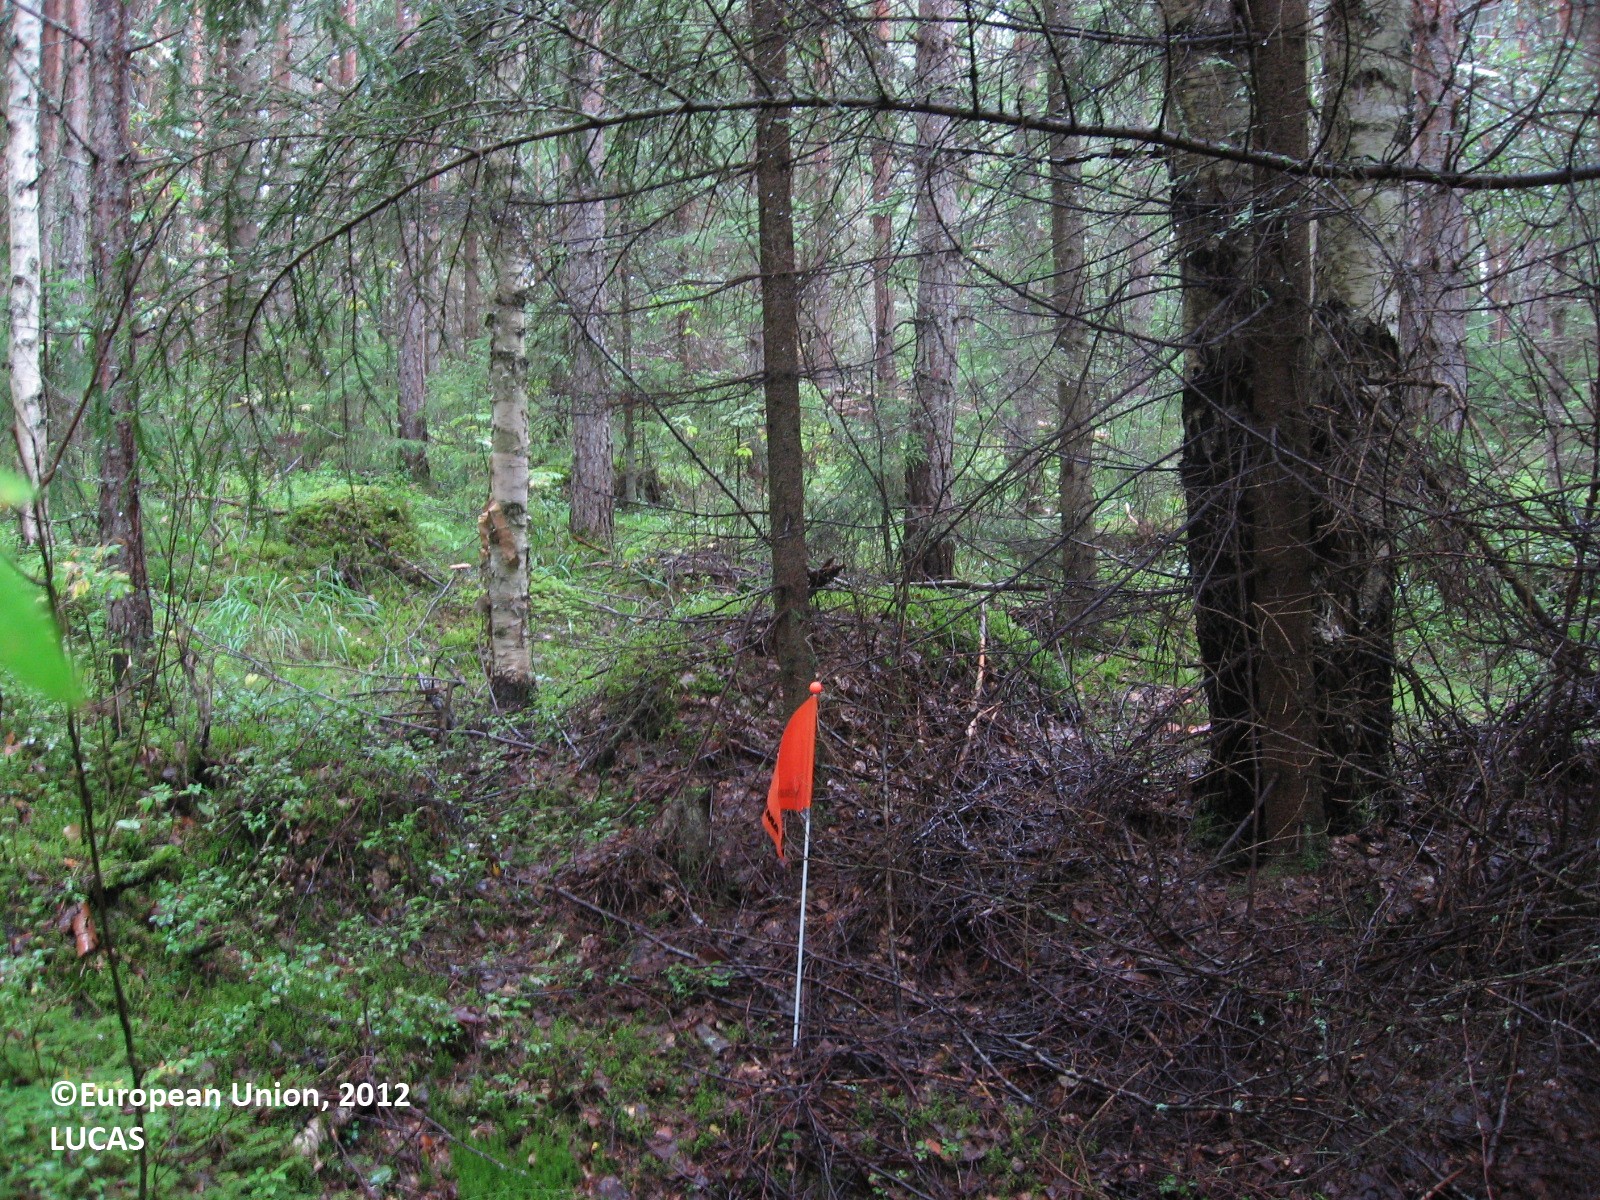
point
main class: Woodland
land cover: Spruce dominated mixed woodland
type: boreal forest
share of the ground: > 75 %
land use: Forestry
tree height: > 5 m
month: August
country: FI
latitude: 60.7220
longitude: 25.0942
